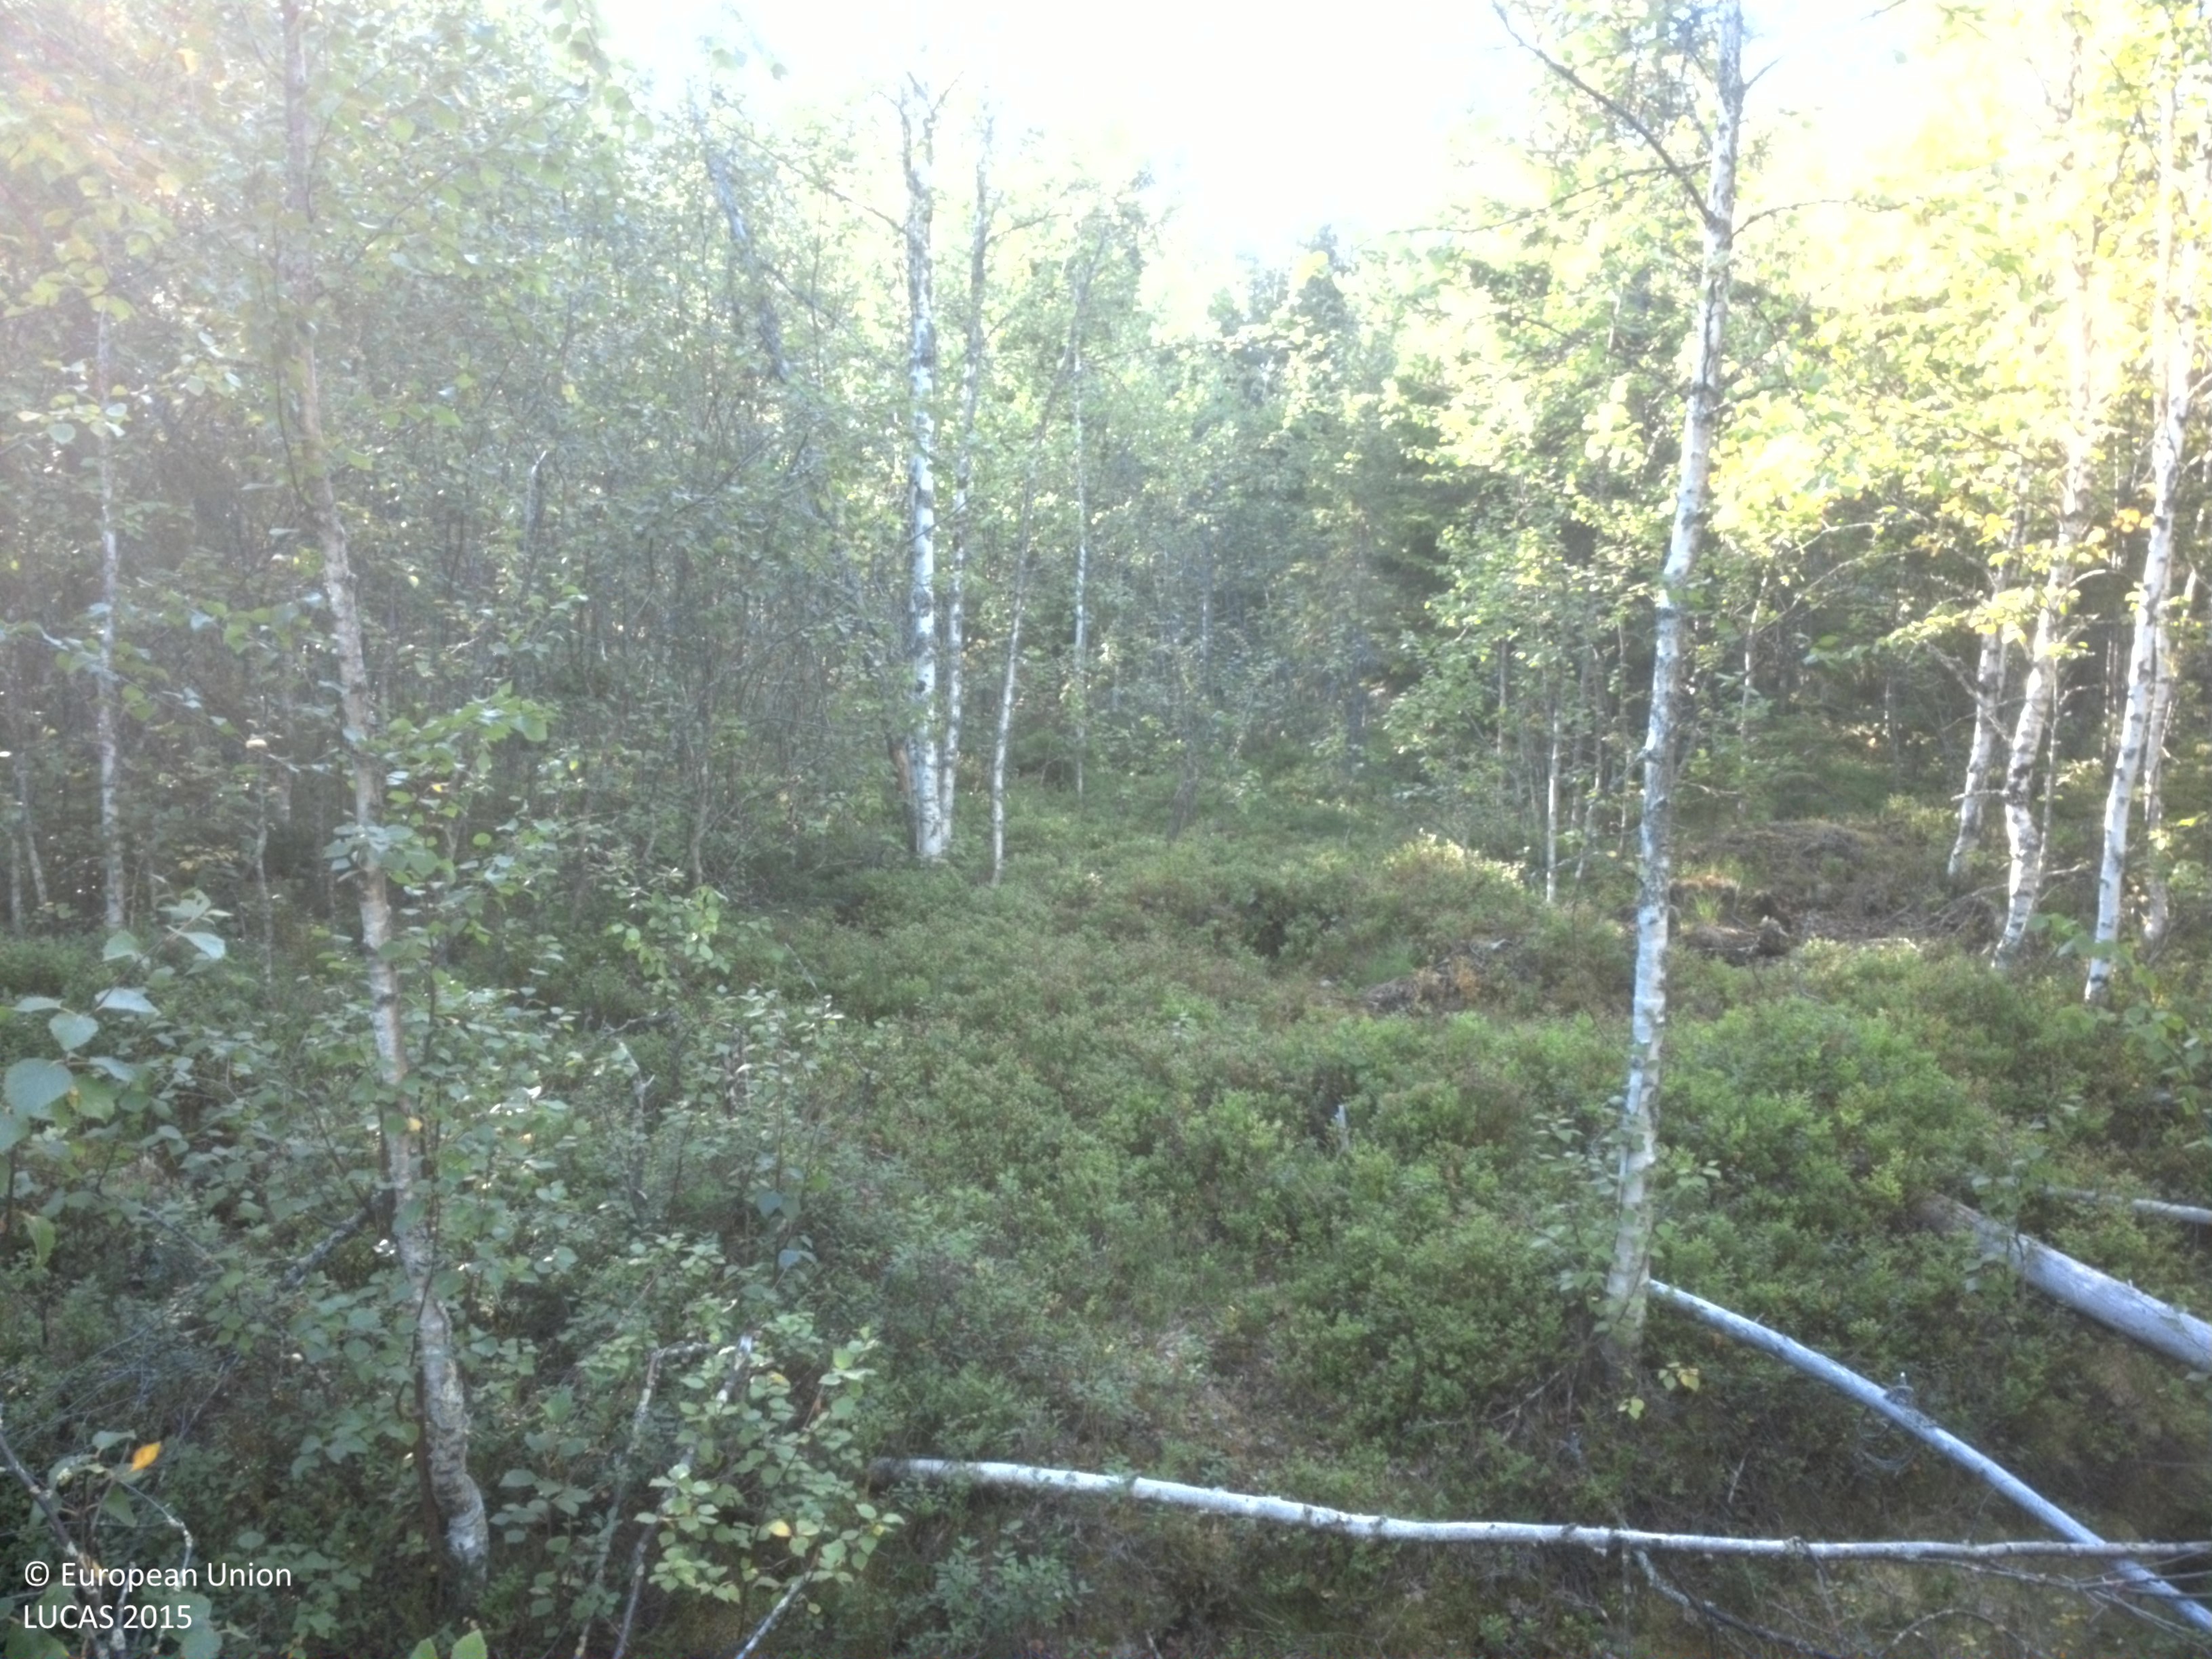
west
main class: Woodland
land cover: Spruce dominated mixed woodland
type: boreal forest
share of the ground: 50 - 75 %
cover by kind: shrubs 40 %, coniferous forest trees 35 %, broadleaved forest trees 15 %, herbaceous plants 5 %, lichens and mosses 5 %
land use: Forestry
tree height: > 5 m
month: August
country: SE
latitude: 64.5742
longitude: 18.4220
